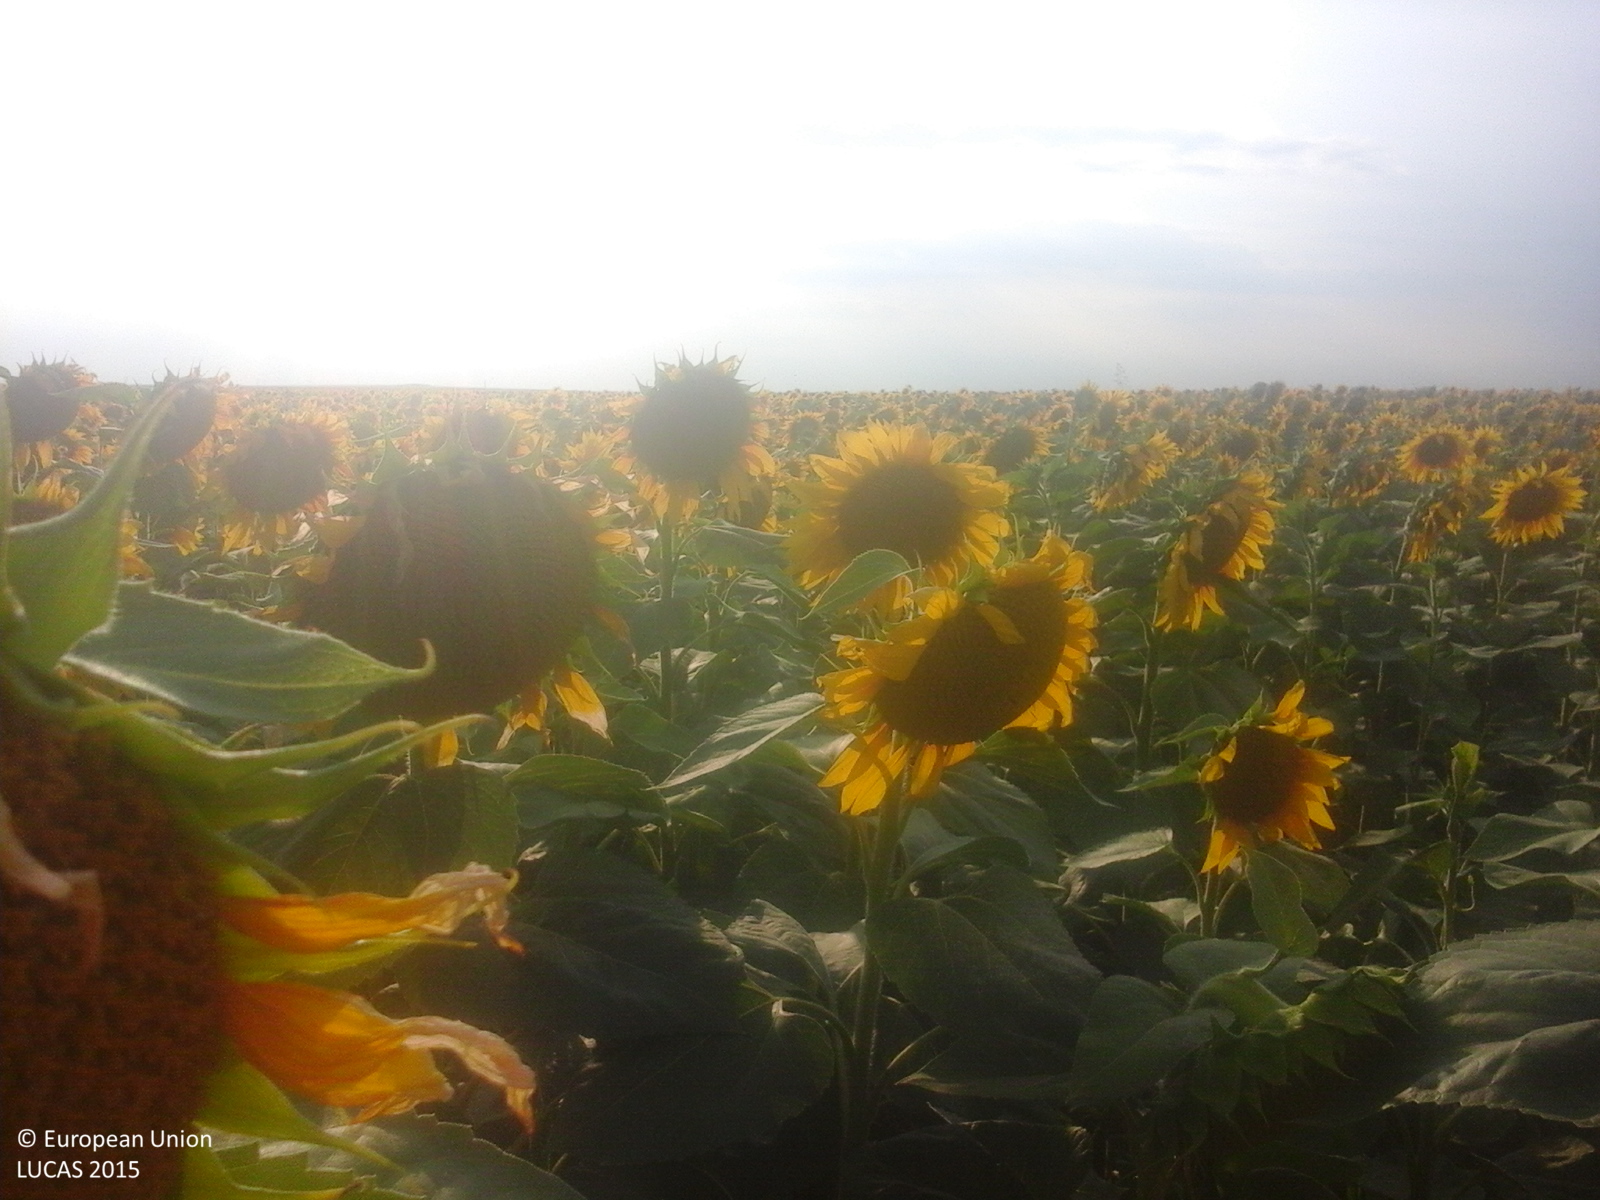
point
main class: Cropland
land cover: Sunflower
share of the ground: > 75 %
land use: Agriculture (excluding fallow land and kitchen gardens)
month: July
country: RO
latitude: 43.8625
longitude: 24.5868
